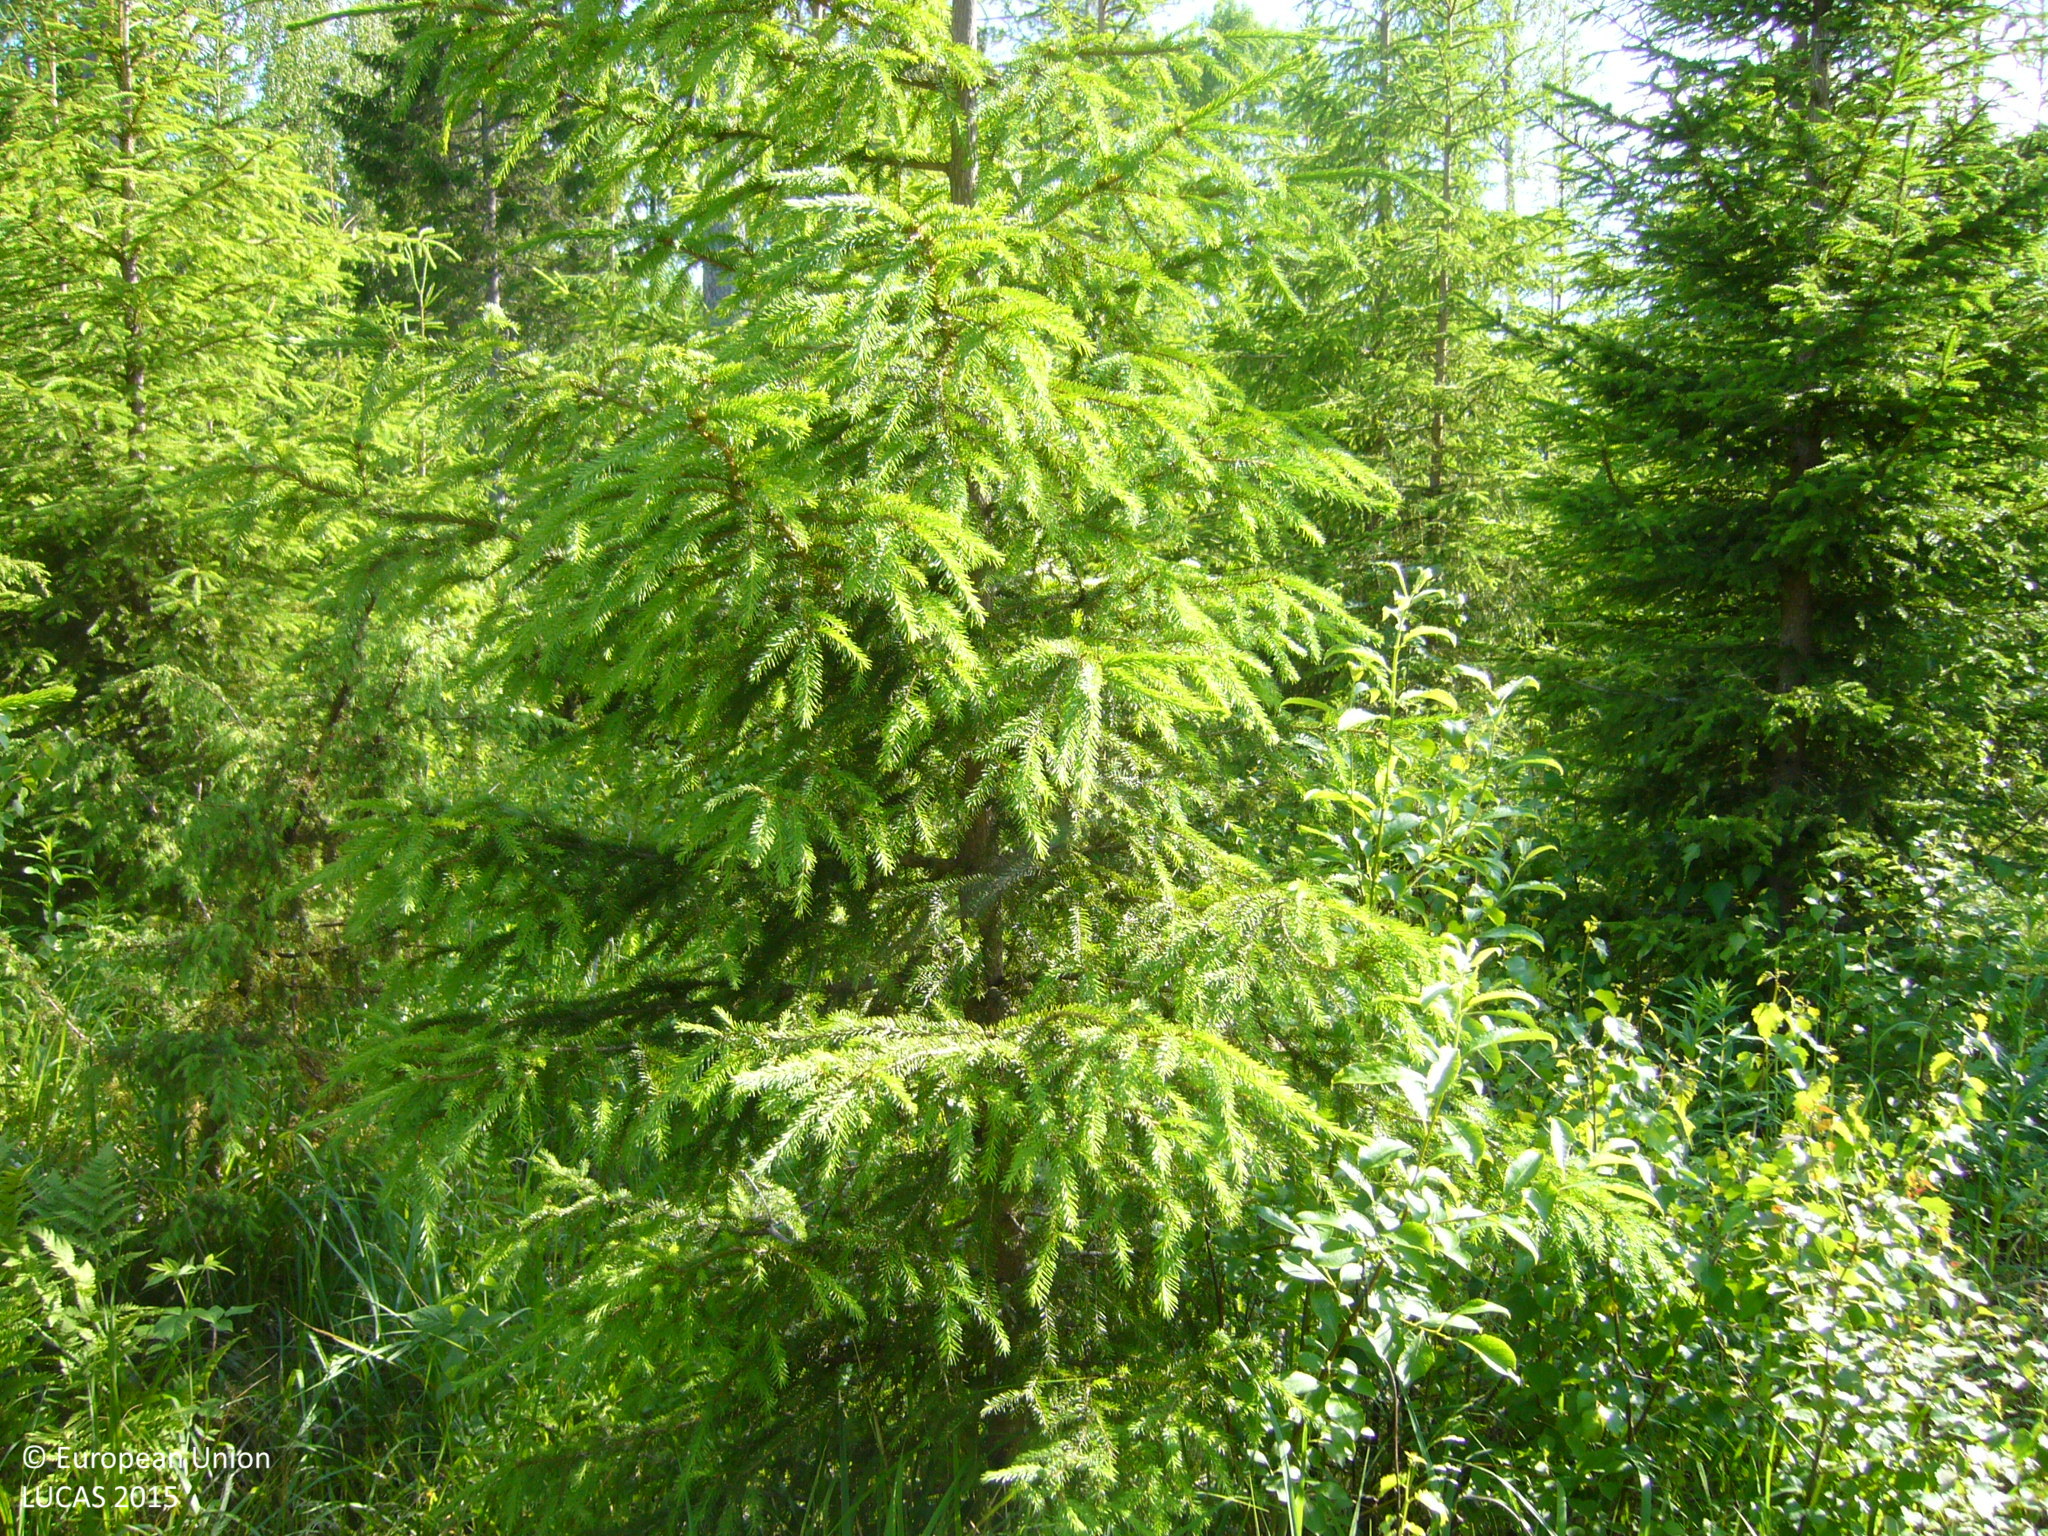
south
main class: Woodland
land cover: Spruce dominated coniferous woodland
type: boreal forest
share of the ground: 50 - 75 %
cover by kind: coniferous forest trees 50 %, shrubs 50 %
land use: Forestry
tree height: < 5 m
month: July
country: FI
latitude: 63.3825
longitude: 26.1020
